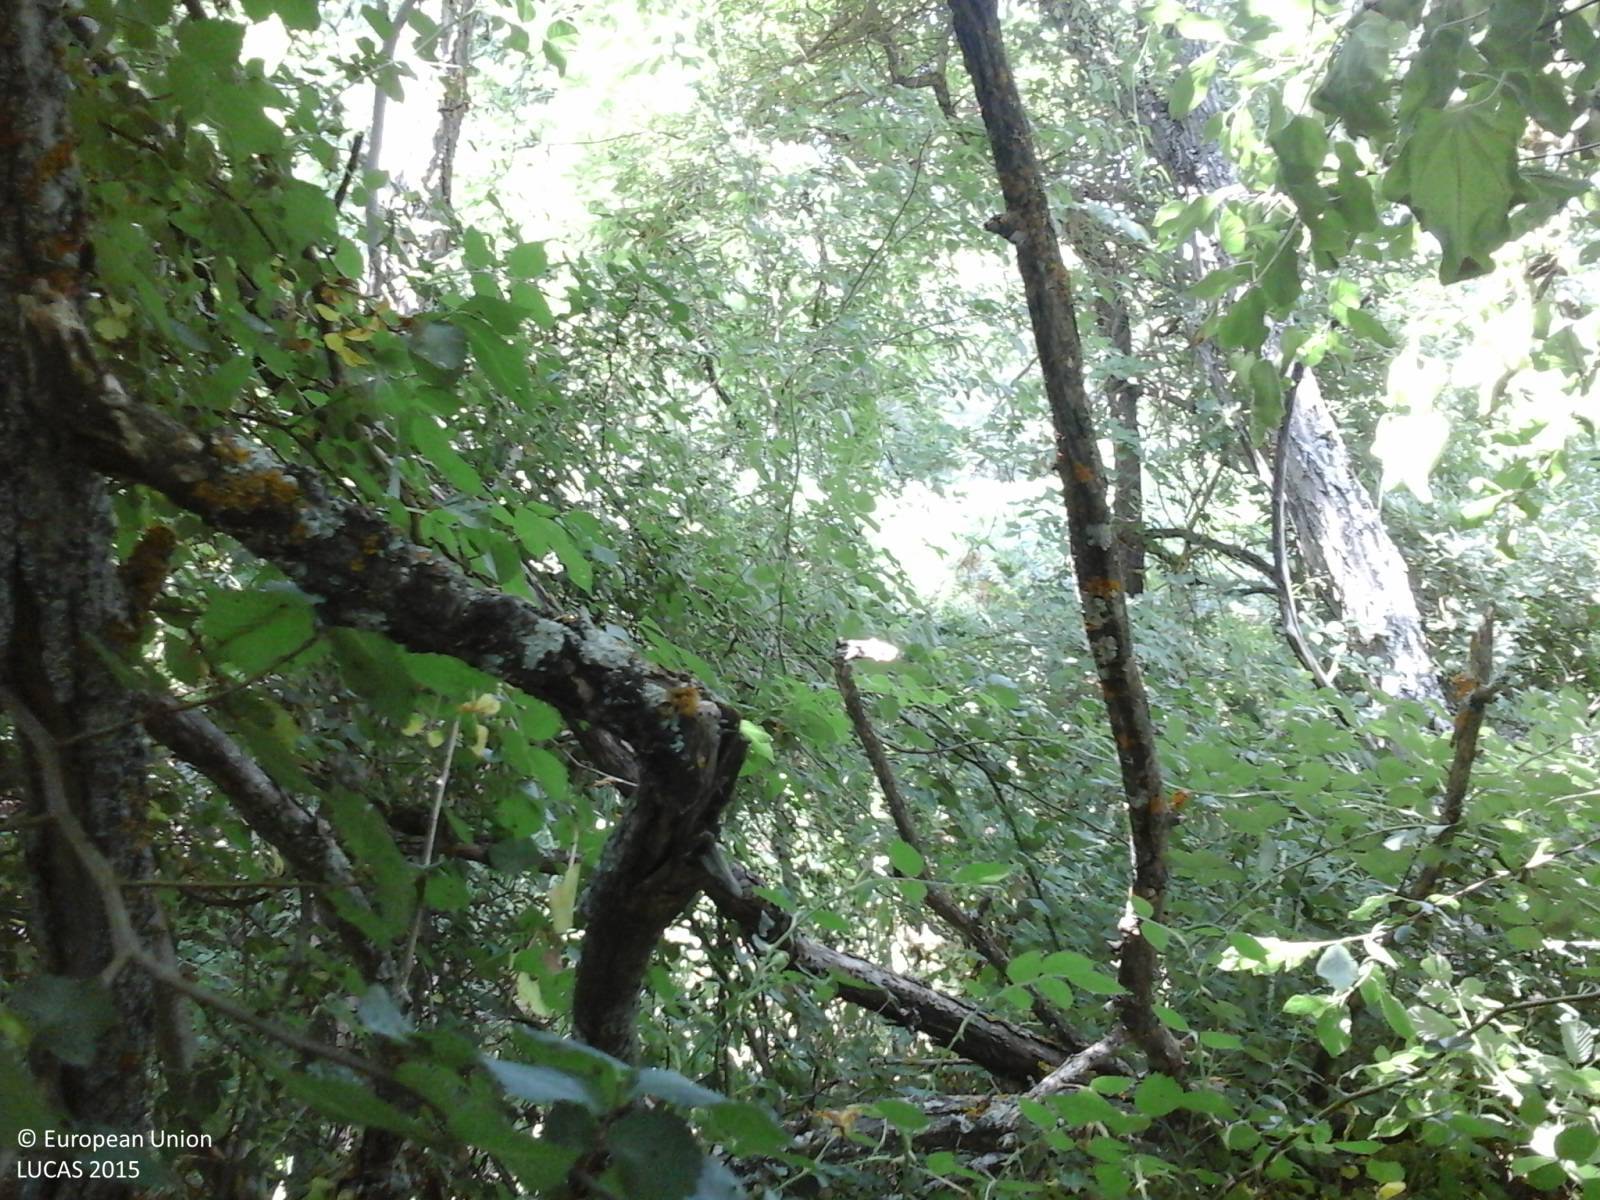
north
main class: Woodland
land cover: Broadleaved woodland
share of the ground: > 75 %
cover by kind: broadleaved forest trees 75 %, herbaceous plants 15 %, shrubs 10 %
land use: Semi-natural and natural areas not in use
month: July
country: IT
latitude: 42.4177
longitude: 13.3556
